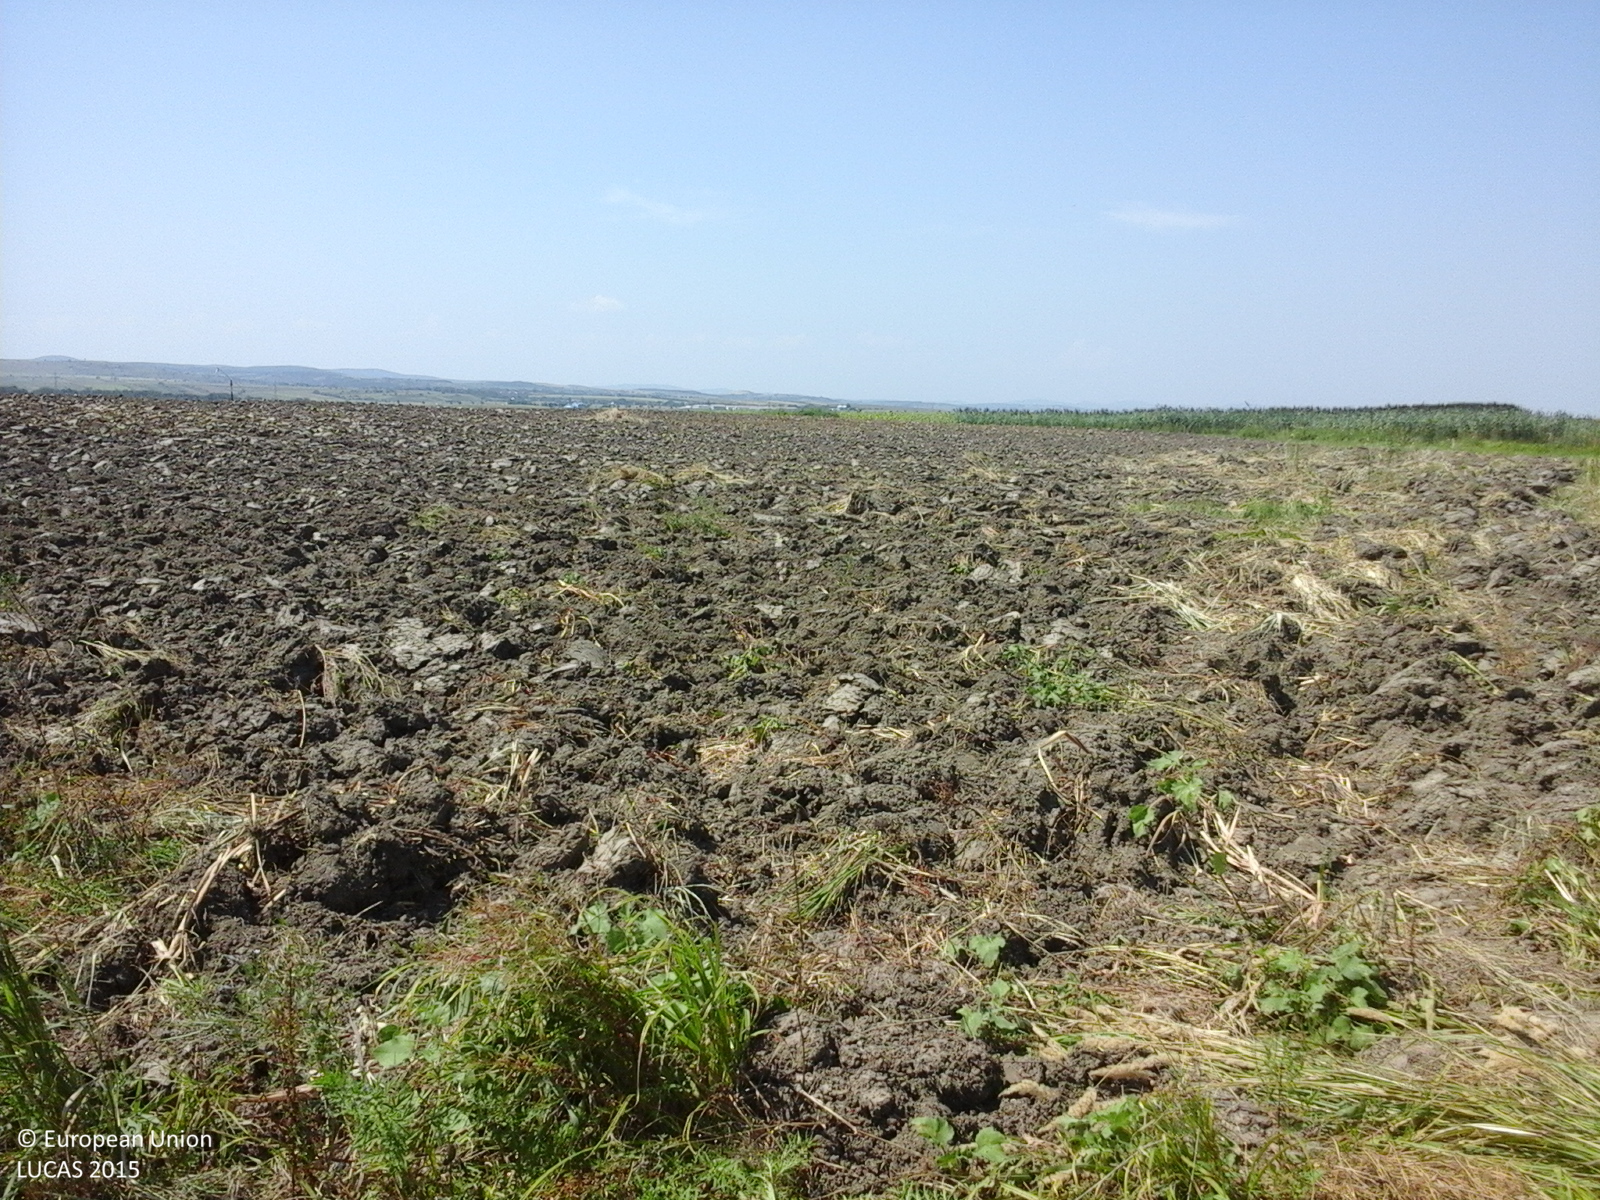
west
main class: Grassland
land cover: Spontaneously vegetated surfaces
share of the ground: > 75 %
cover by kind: herbaceous plants 100 %
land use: Fallow land
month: August
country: RO
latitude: 46.2269
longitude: 27.1210
